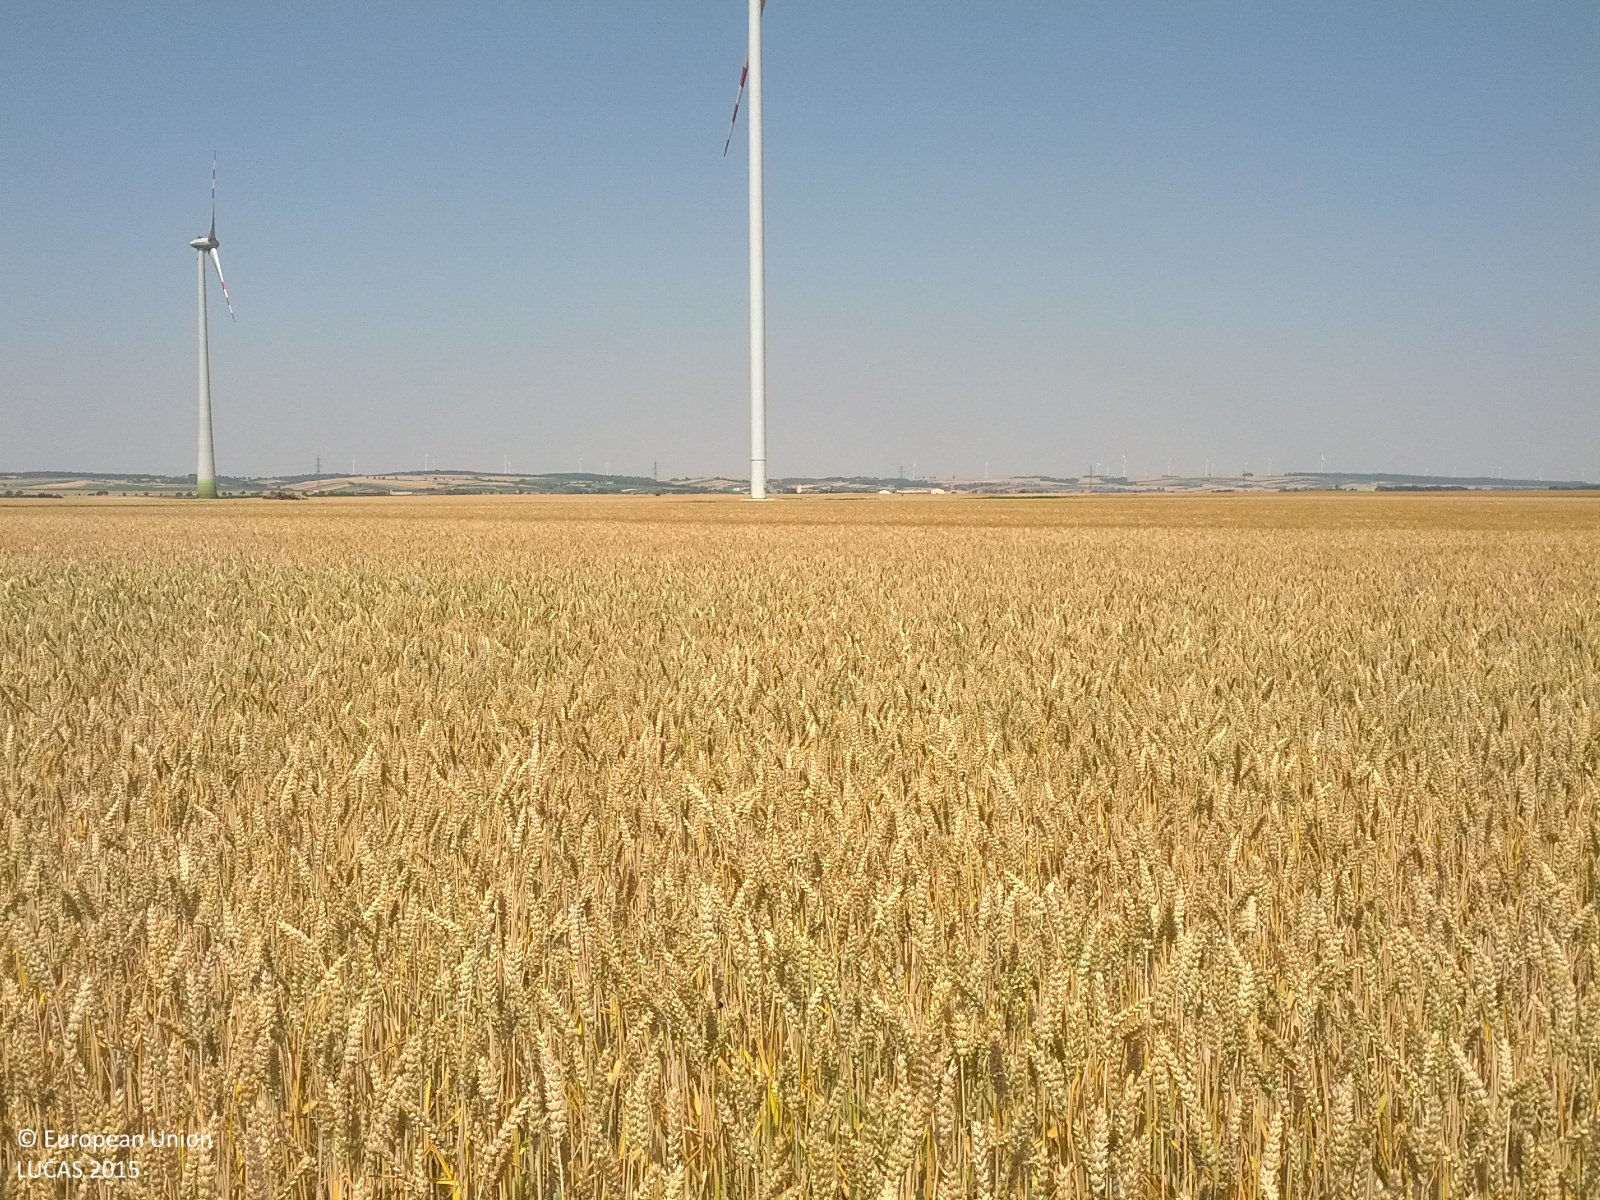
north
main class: Cropland
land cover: Barley
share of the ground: > 75 %
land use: Agriculture (excluding fallow land and kitchen gardens)
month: July
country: AT
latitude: 48.5018
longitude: 16.7878
